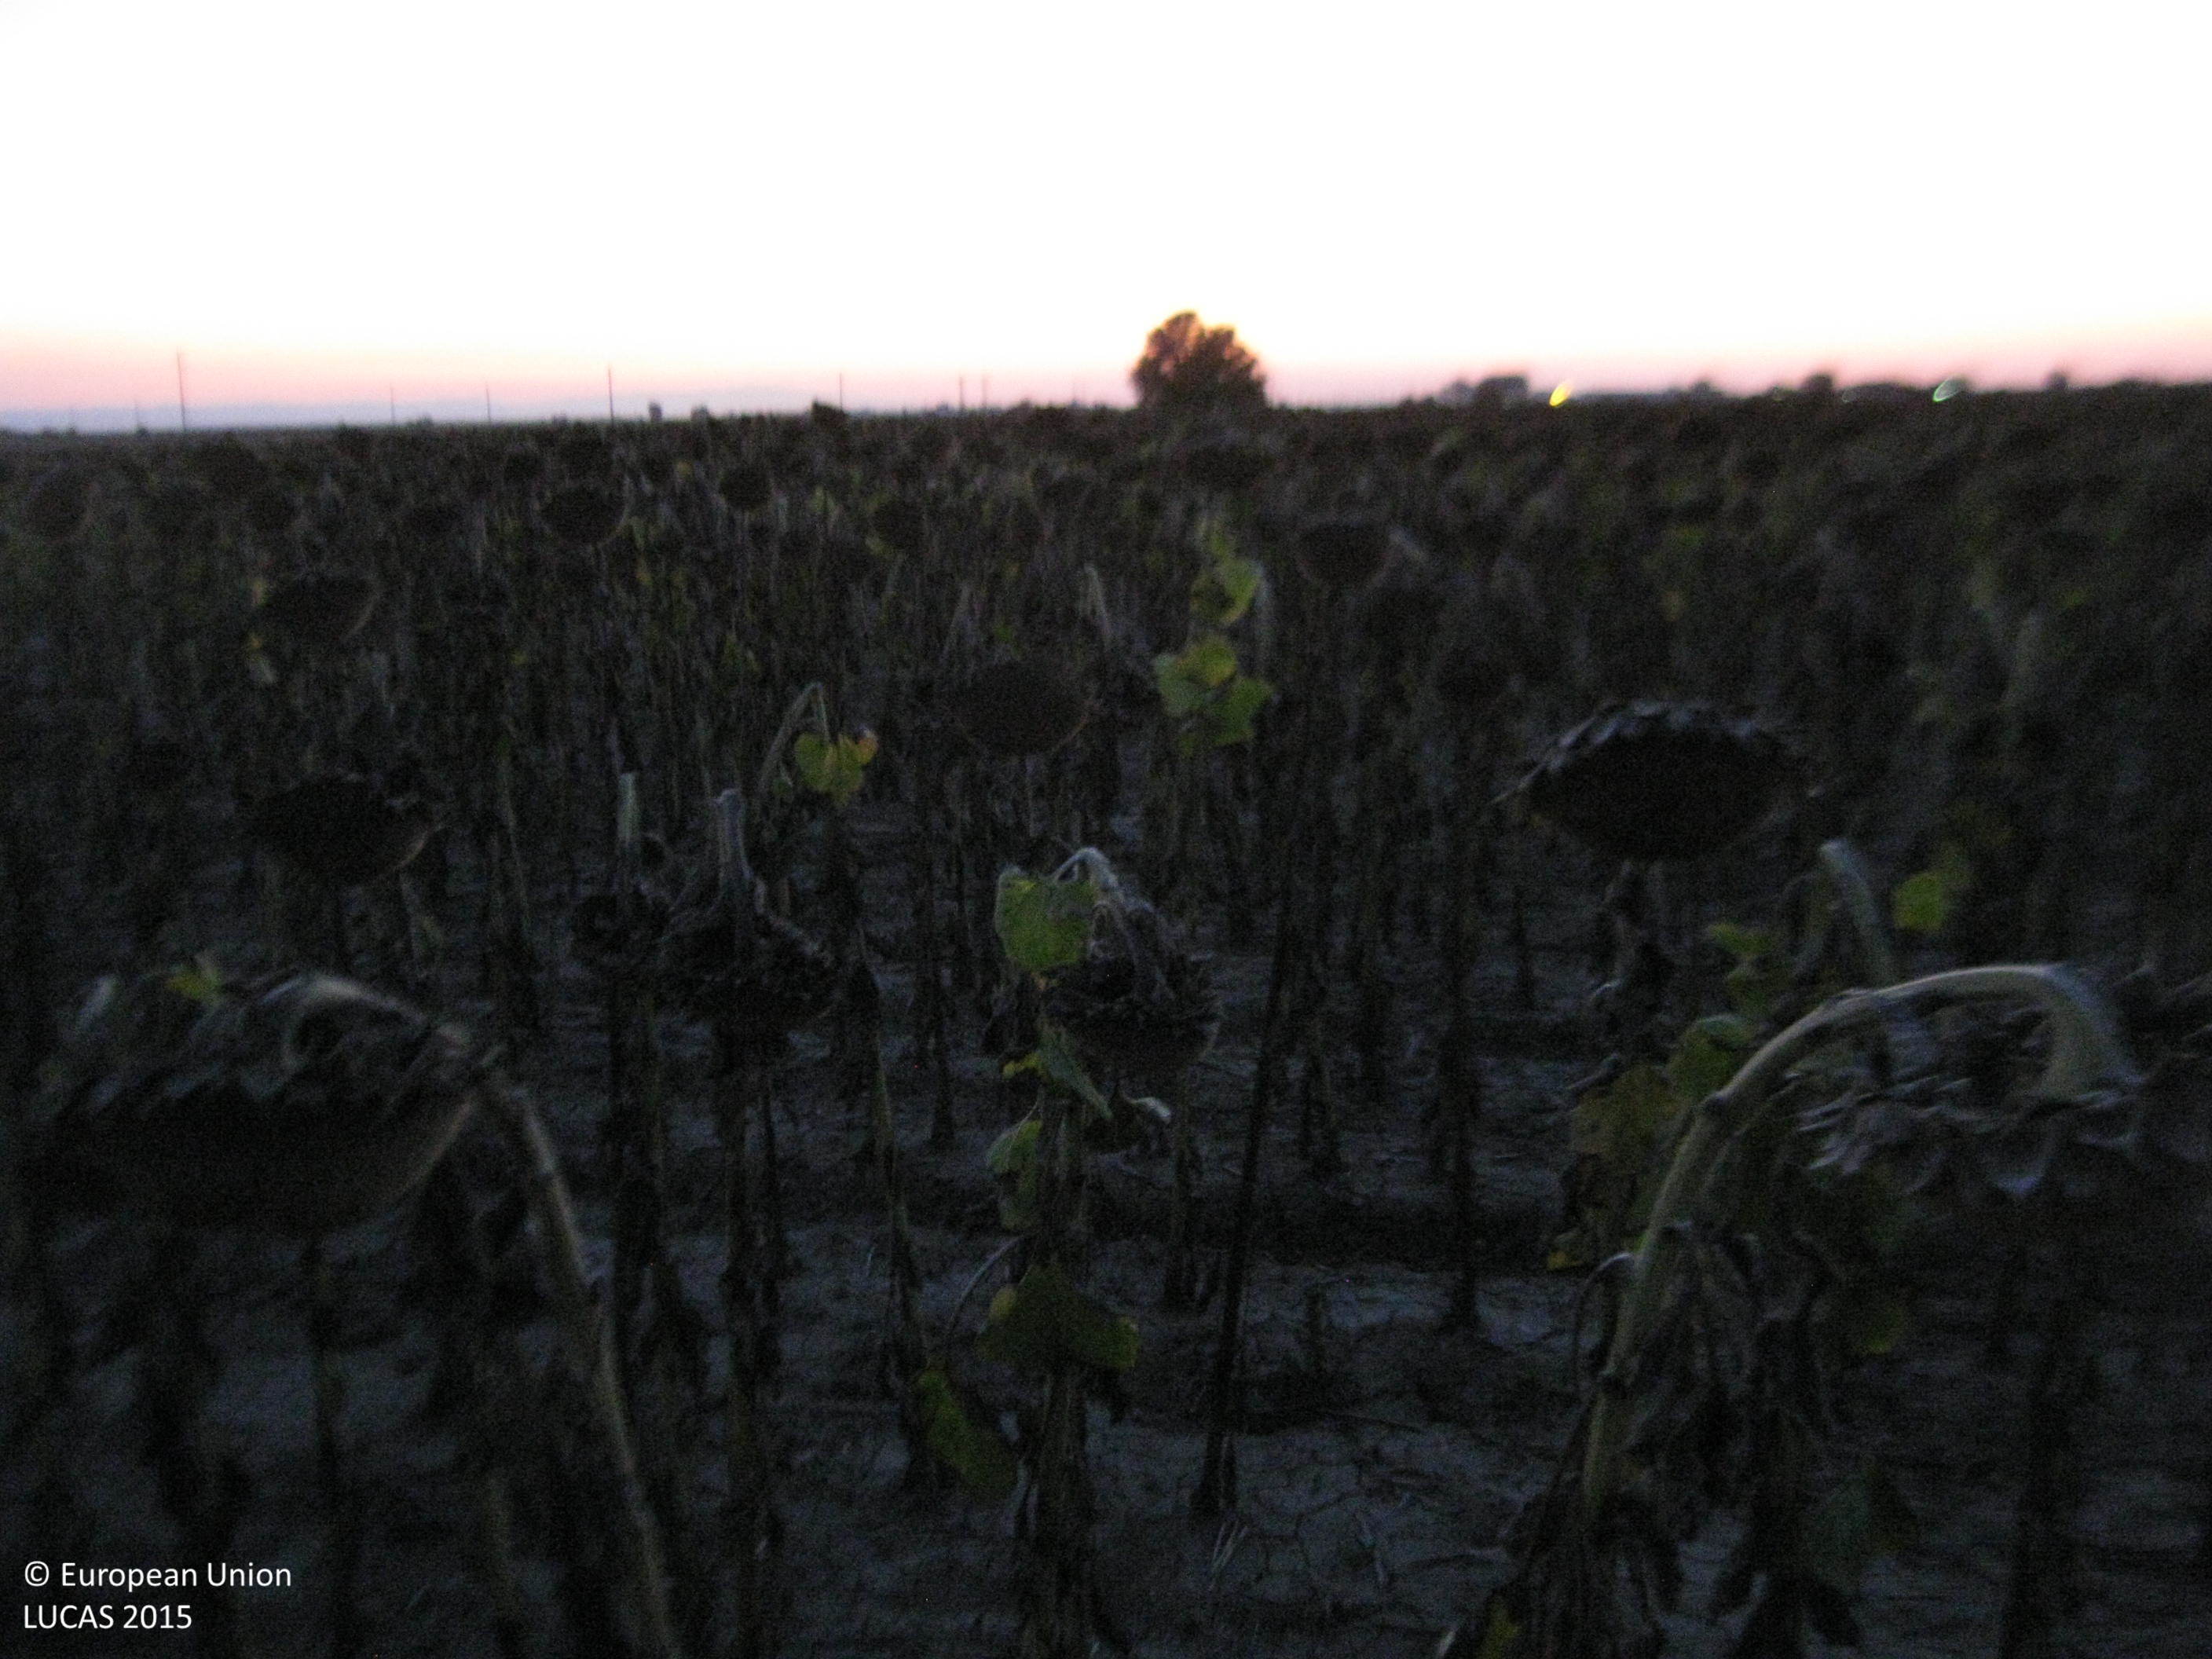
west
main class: Cropland
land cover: Sunflower
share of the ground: > 75 %
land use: Agriculture (excluding fallow land and kitchen gardens)
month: August
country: BG
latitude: 42.1810
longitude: 25.0584
